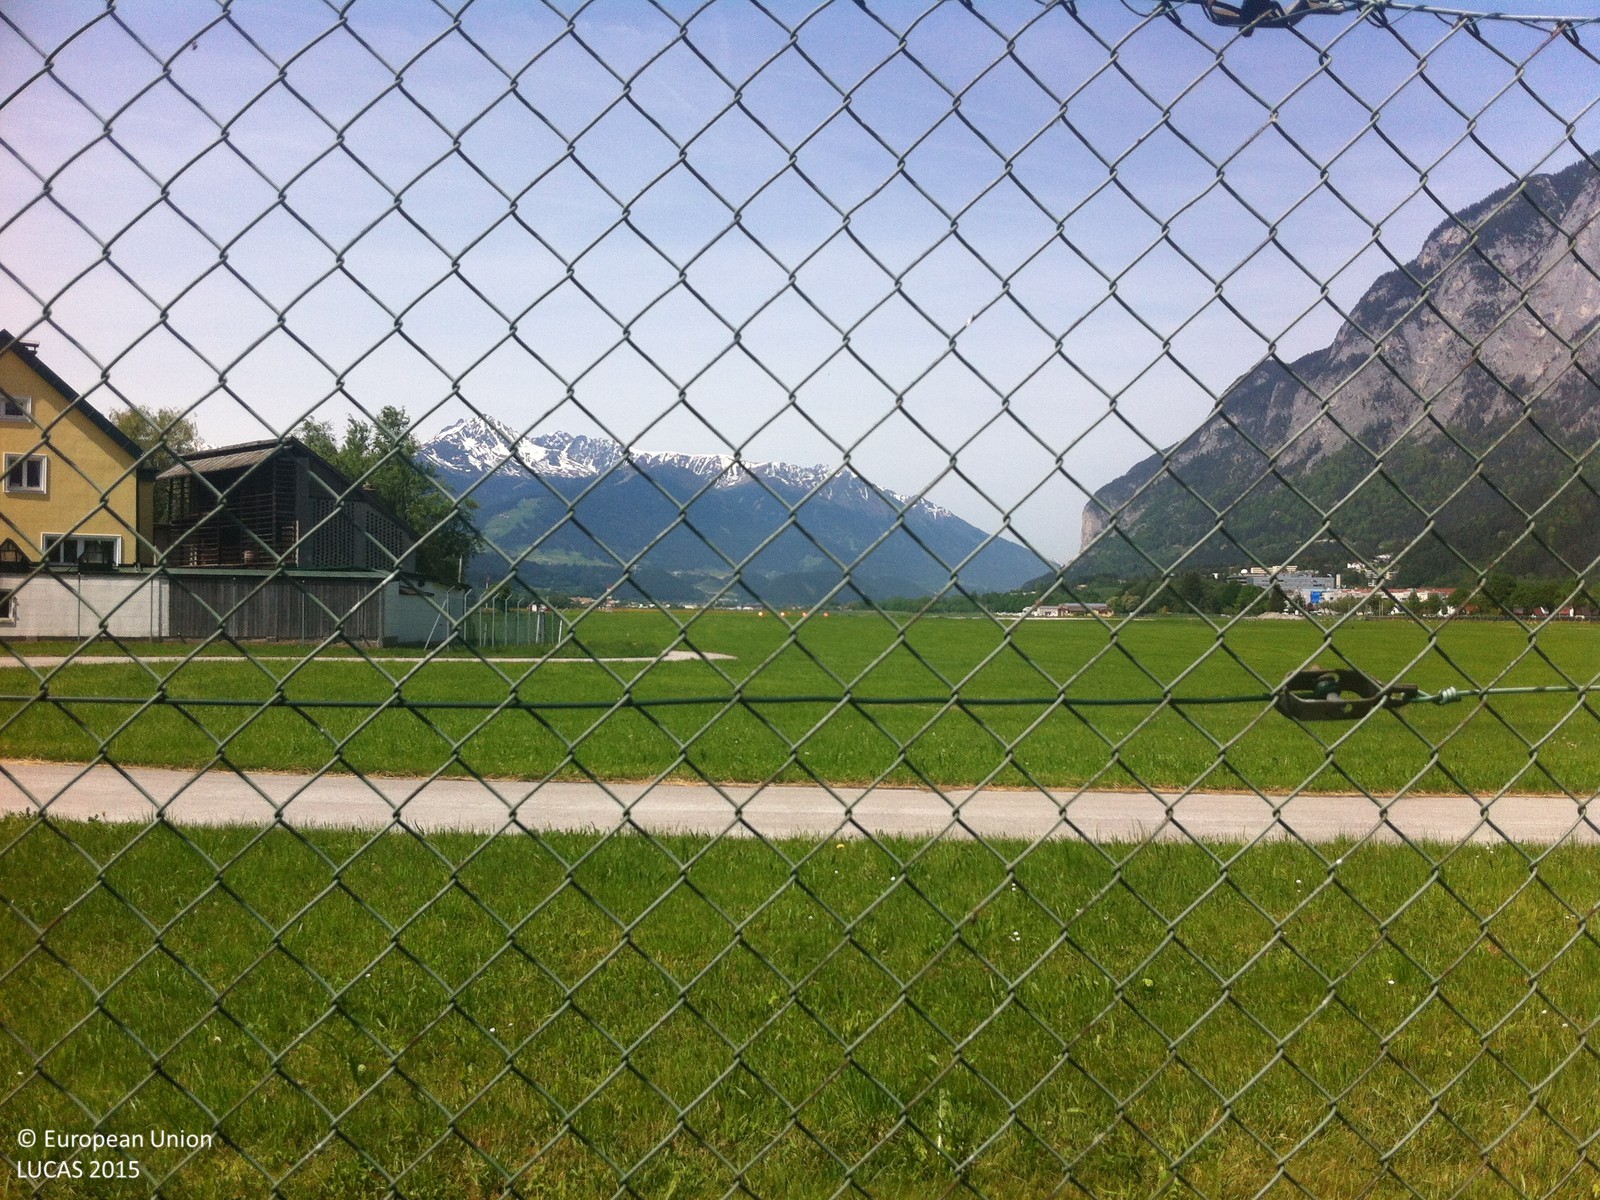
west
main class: Grassland
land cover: Grassland without tree/shrub cover
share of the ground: > 75 %
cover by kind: herbaceous plants 100 %
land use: Air transport
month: May
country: AT
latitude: 47.2611
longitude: 11.3599
